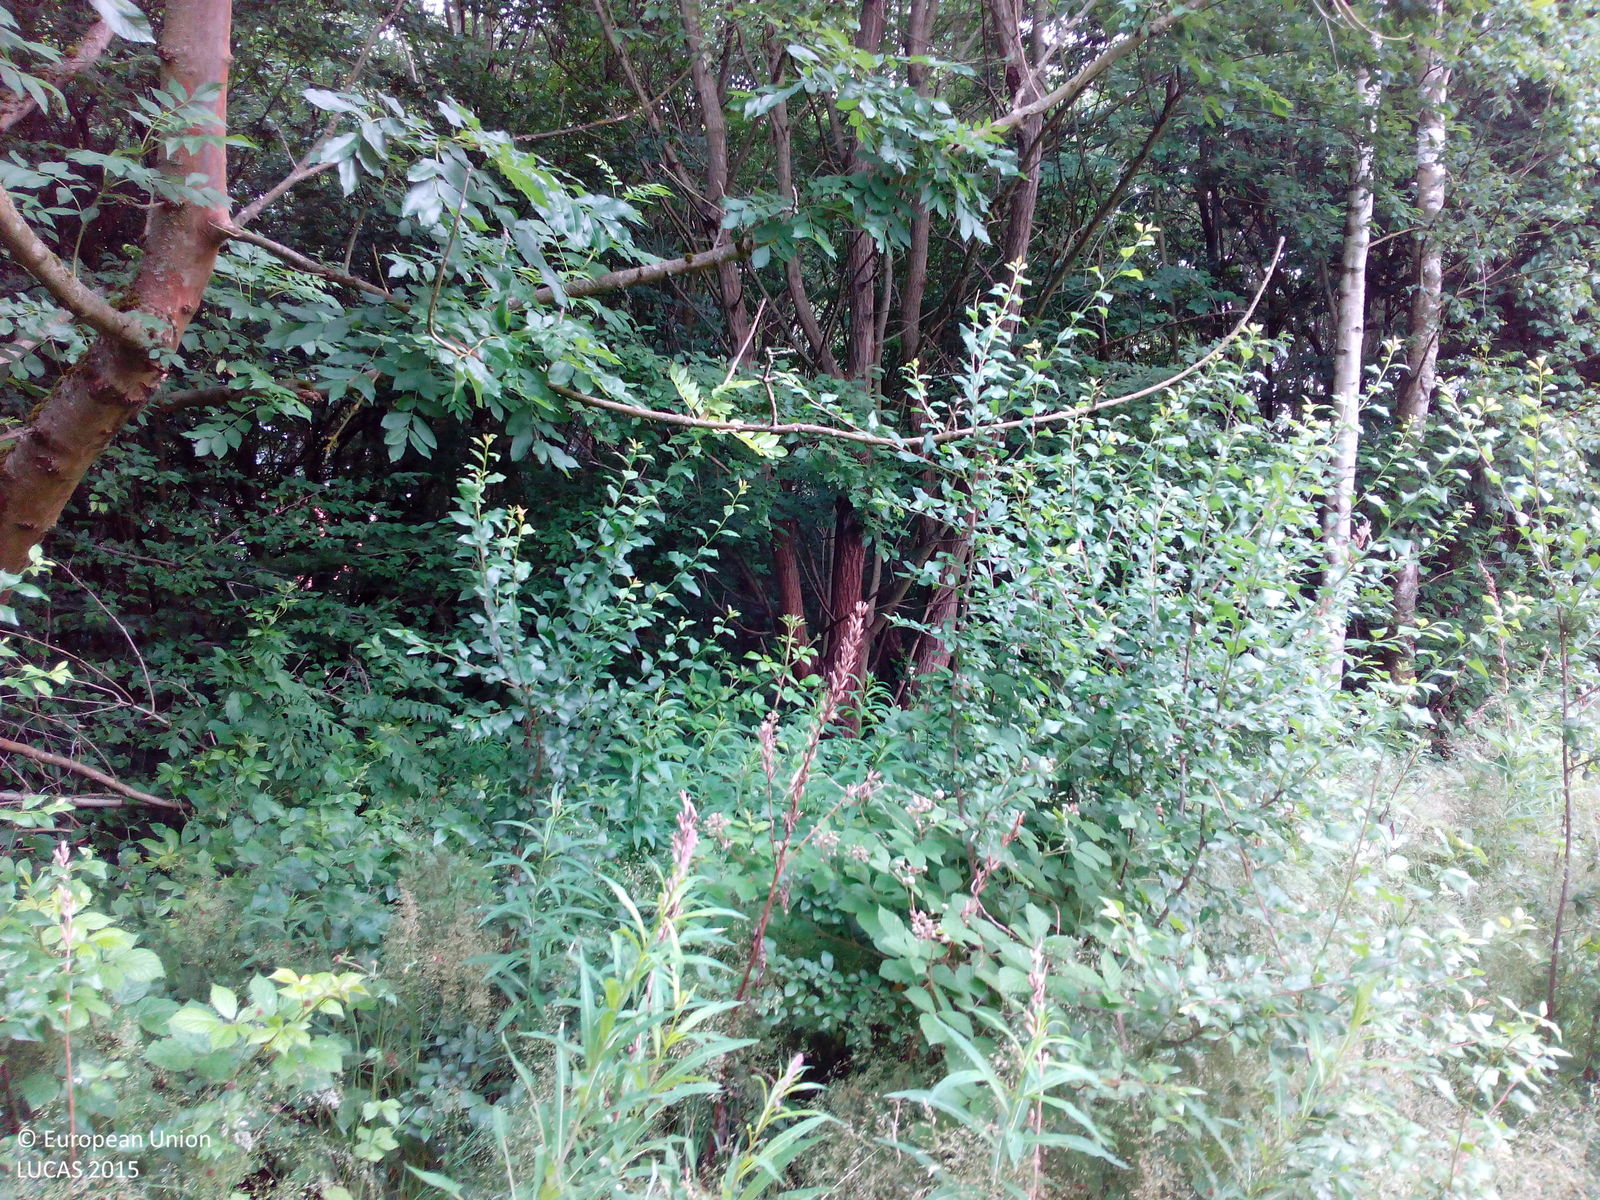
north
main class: Woodland
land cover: Broadleaved woodland
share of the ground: 50 - 75 %
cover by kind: broadleaved forest trees 70 %, herbaceous plants 30 %
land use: Residential
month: June
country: DE
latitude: 51.6579
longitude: 9.6387
